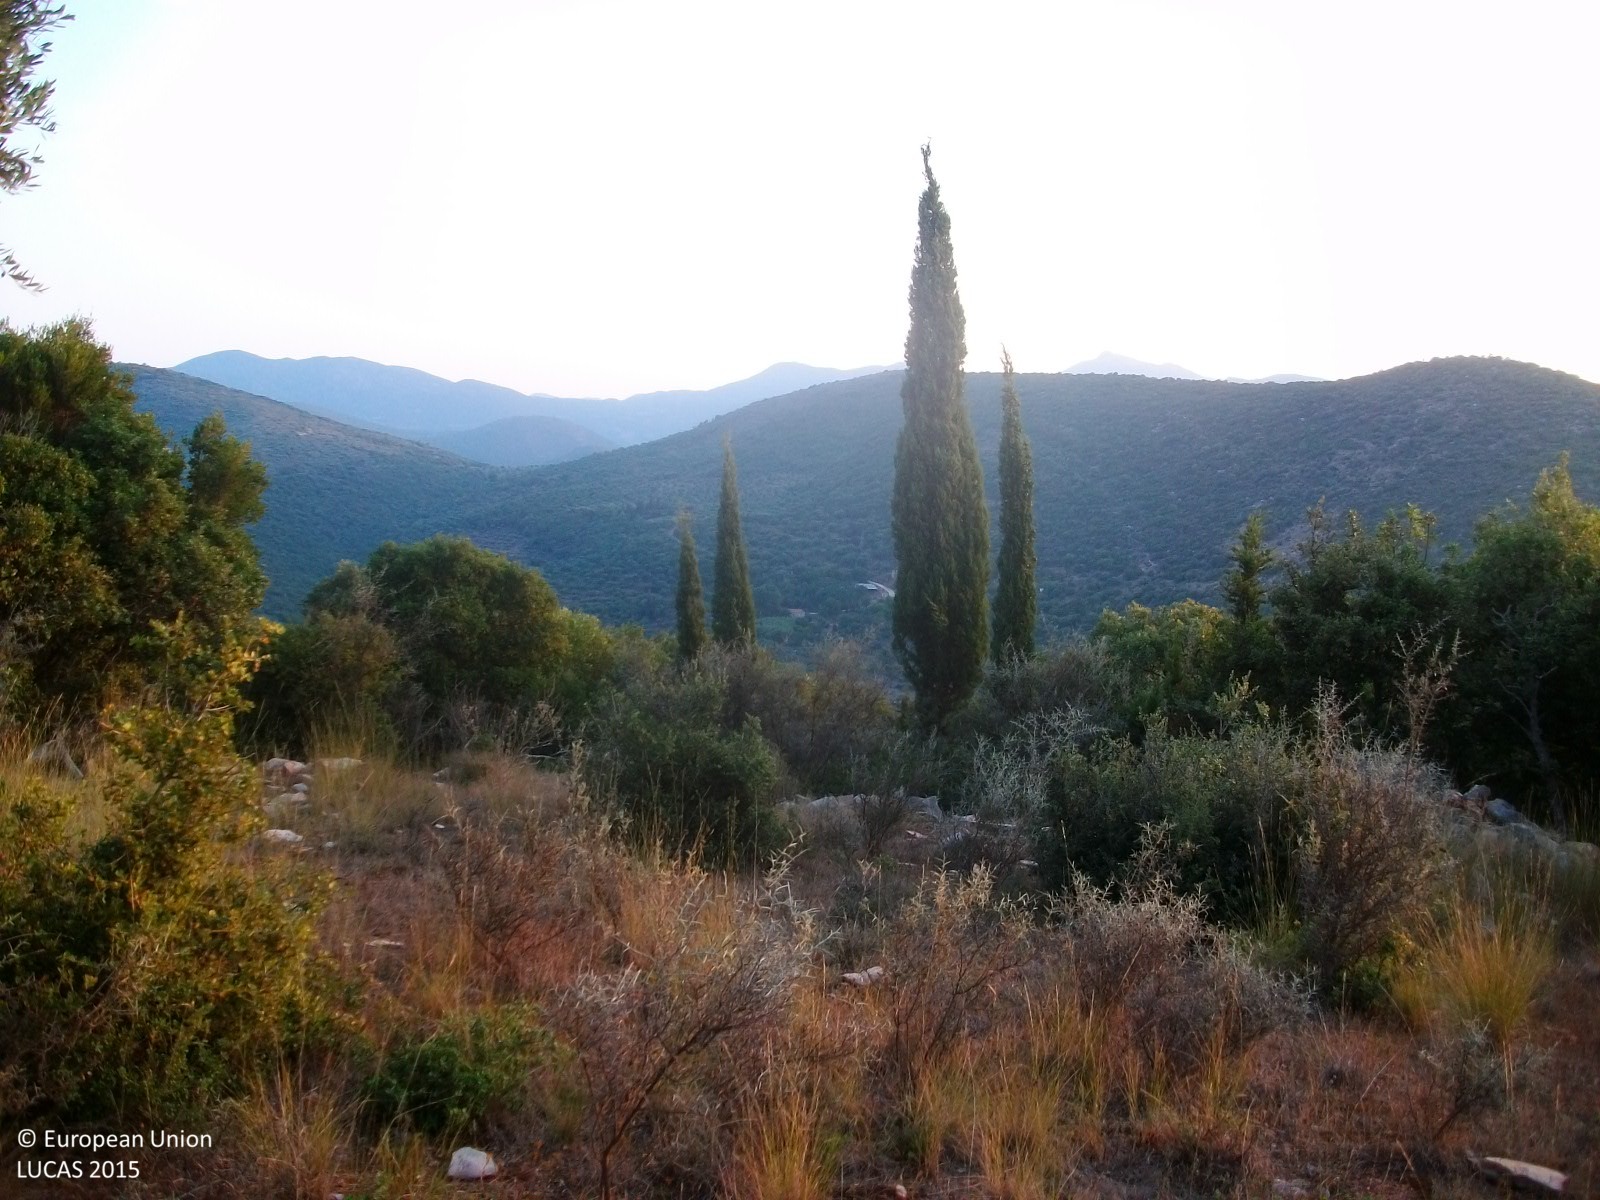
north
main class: Shrubland
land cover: Shrubland without tree cover
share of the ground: 25 - 50 %
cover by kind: herbaceous plants 70 %, shrubs 30 %
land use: Semi-natural and natural areas not in use
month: August
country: GR
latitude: 37.2696
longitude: 21.9206
